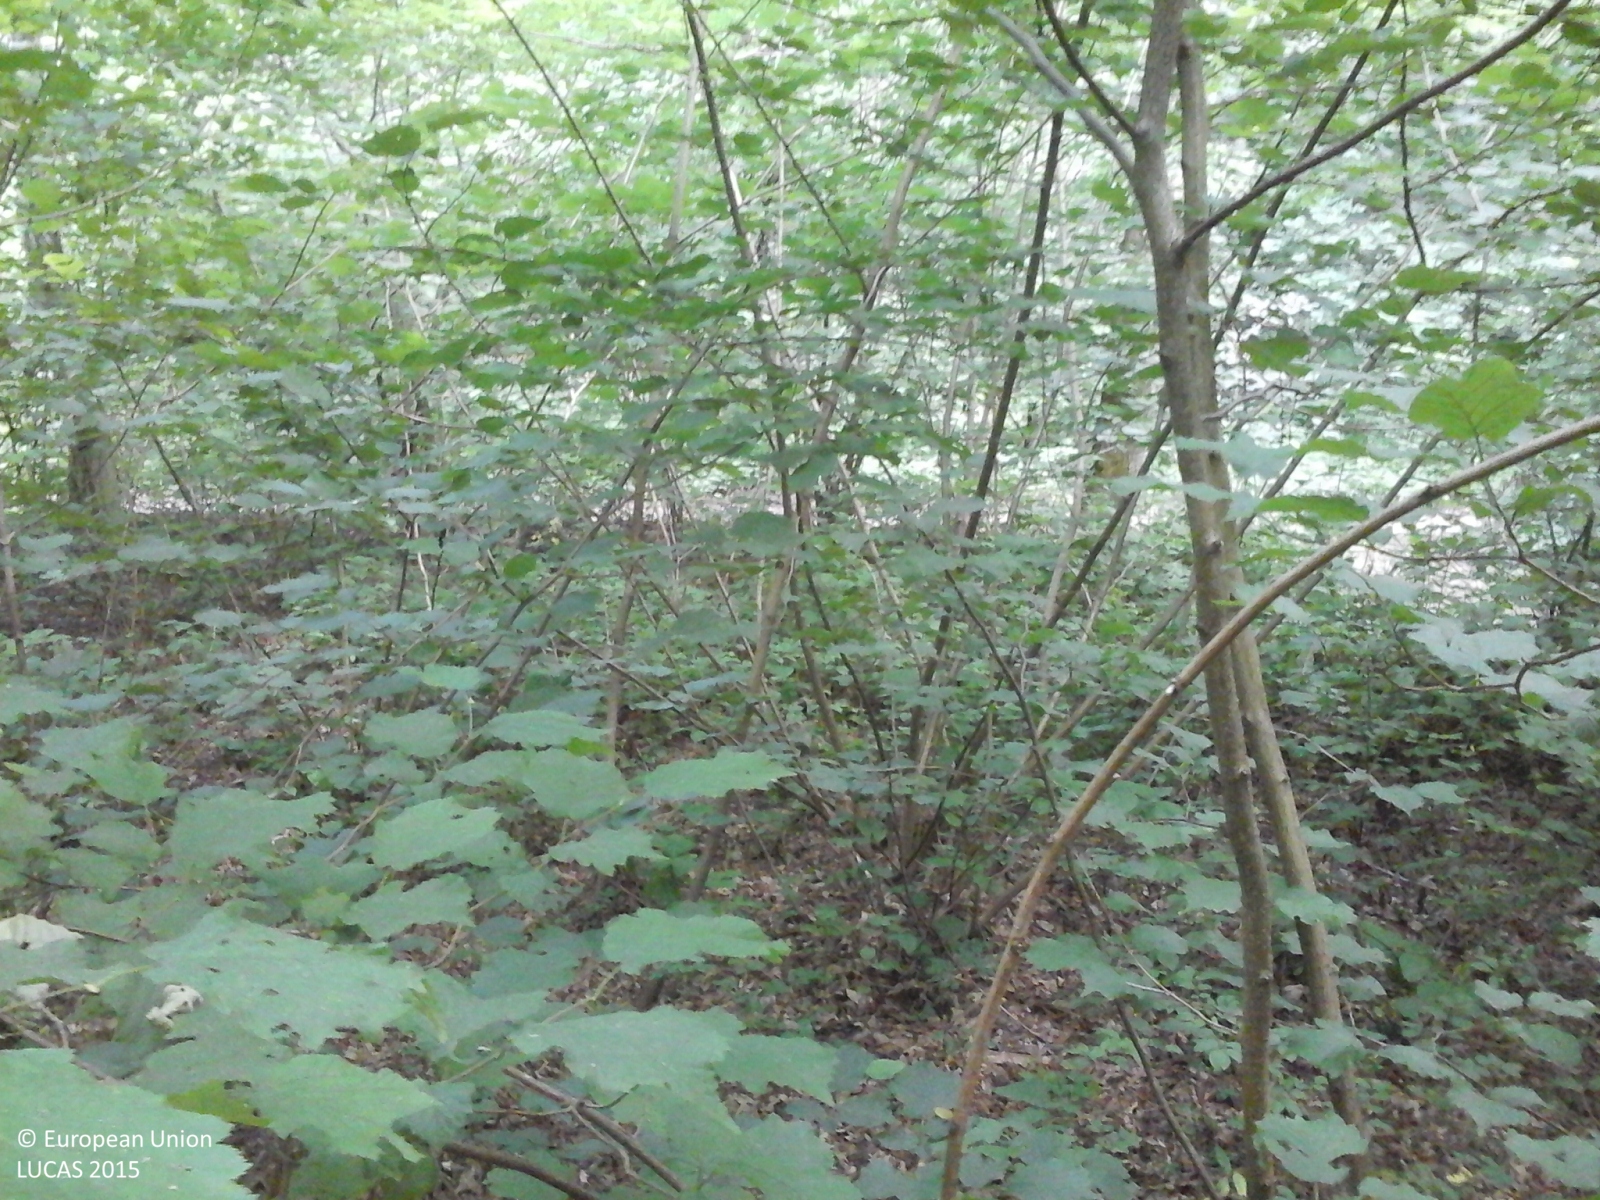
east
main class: Woodland
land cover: Broadleaved woodland
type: thermophilous deciduous forest
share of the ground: > 75 %
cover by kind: broadleaved forest trees 95 %, coniferous forest trees 5 %
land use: Forestry
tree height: > 5 m
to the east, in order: Broadleaved woodland; Tracks; Broadleaved woodland; Tracks; Broadleaved woodland; Dry stone walls; Broadleaved woodland
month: June
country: IT
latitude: 45.8749
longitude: 8.7007
